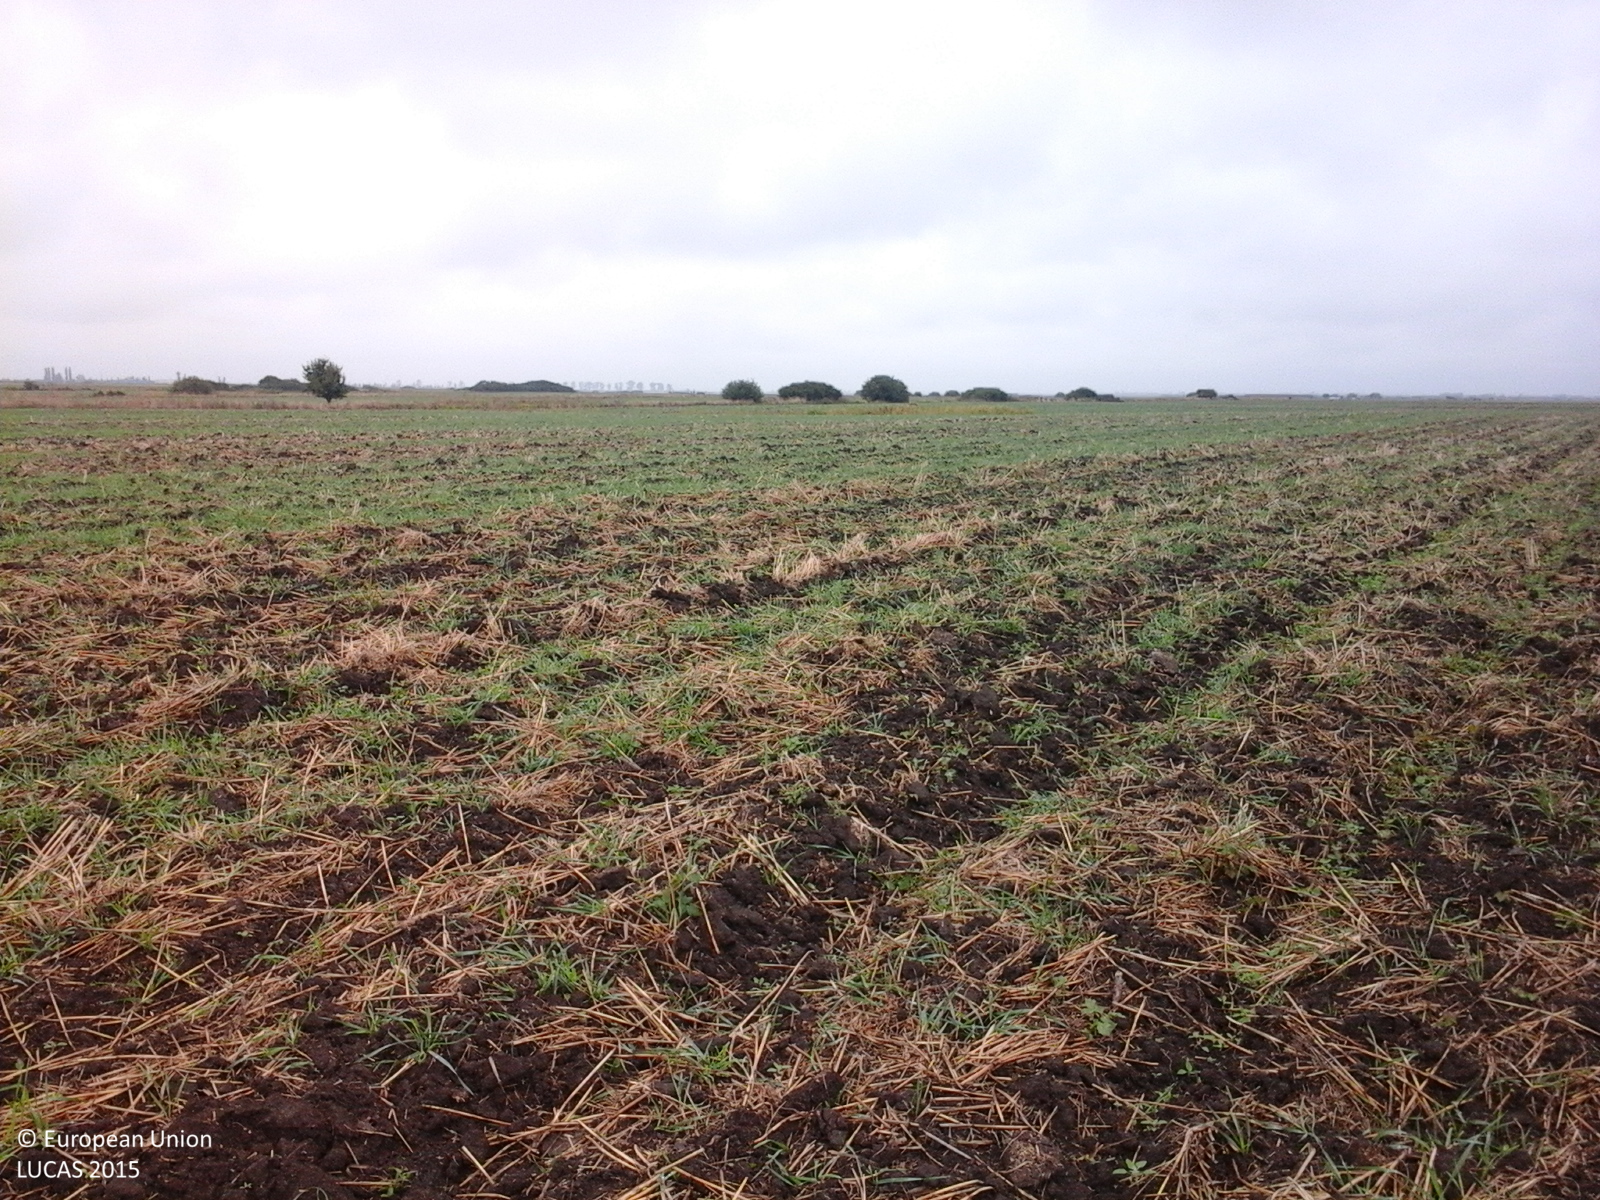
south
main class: Cropland
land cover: Common wheat
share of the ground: < 10 %
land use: Agriculture (excluding fallow land and kitchen gardens)
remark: Harvested field
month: September
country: RO
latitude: 46.8702
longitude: 21.7055
